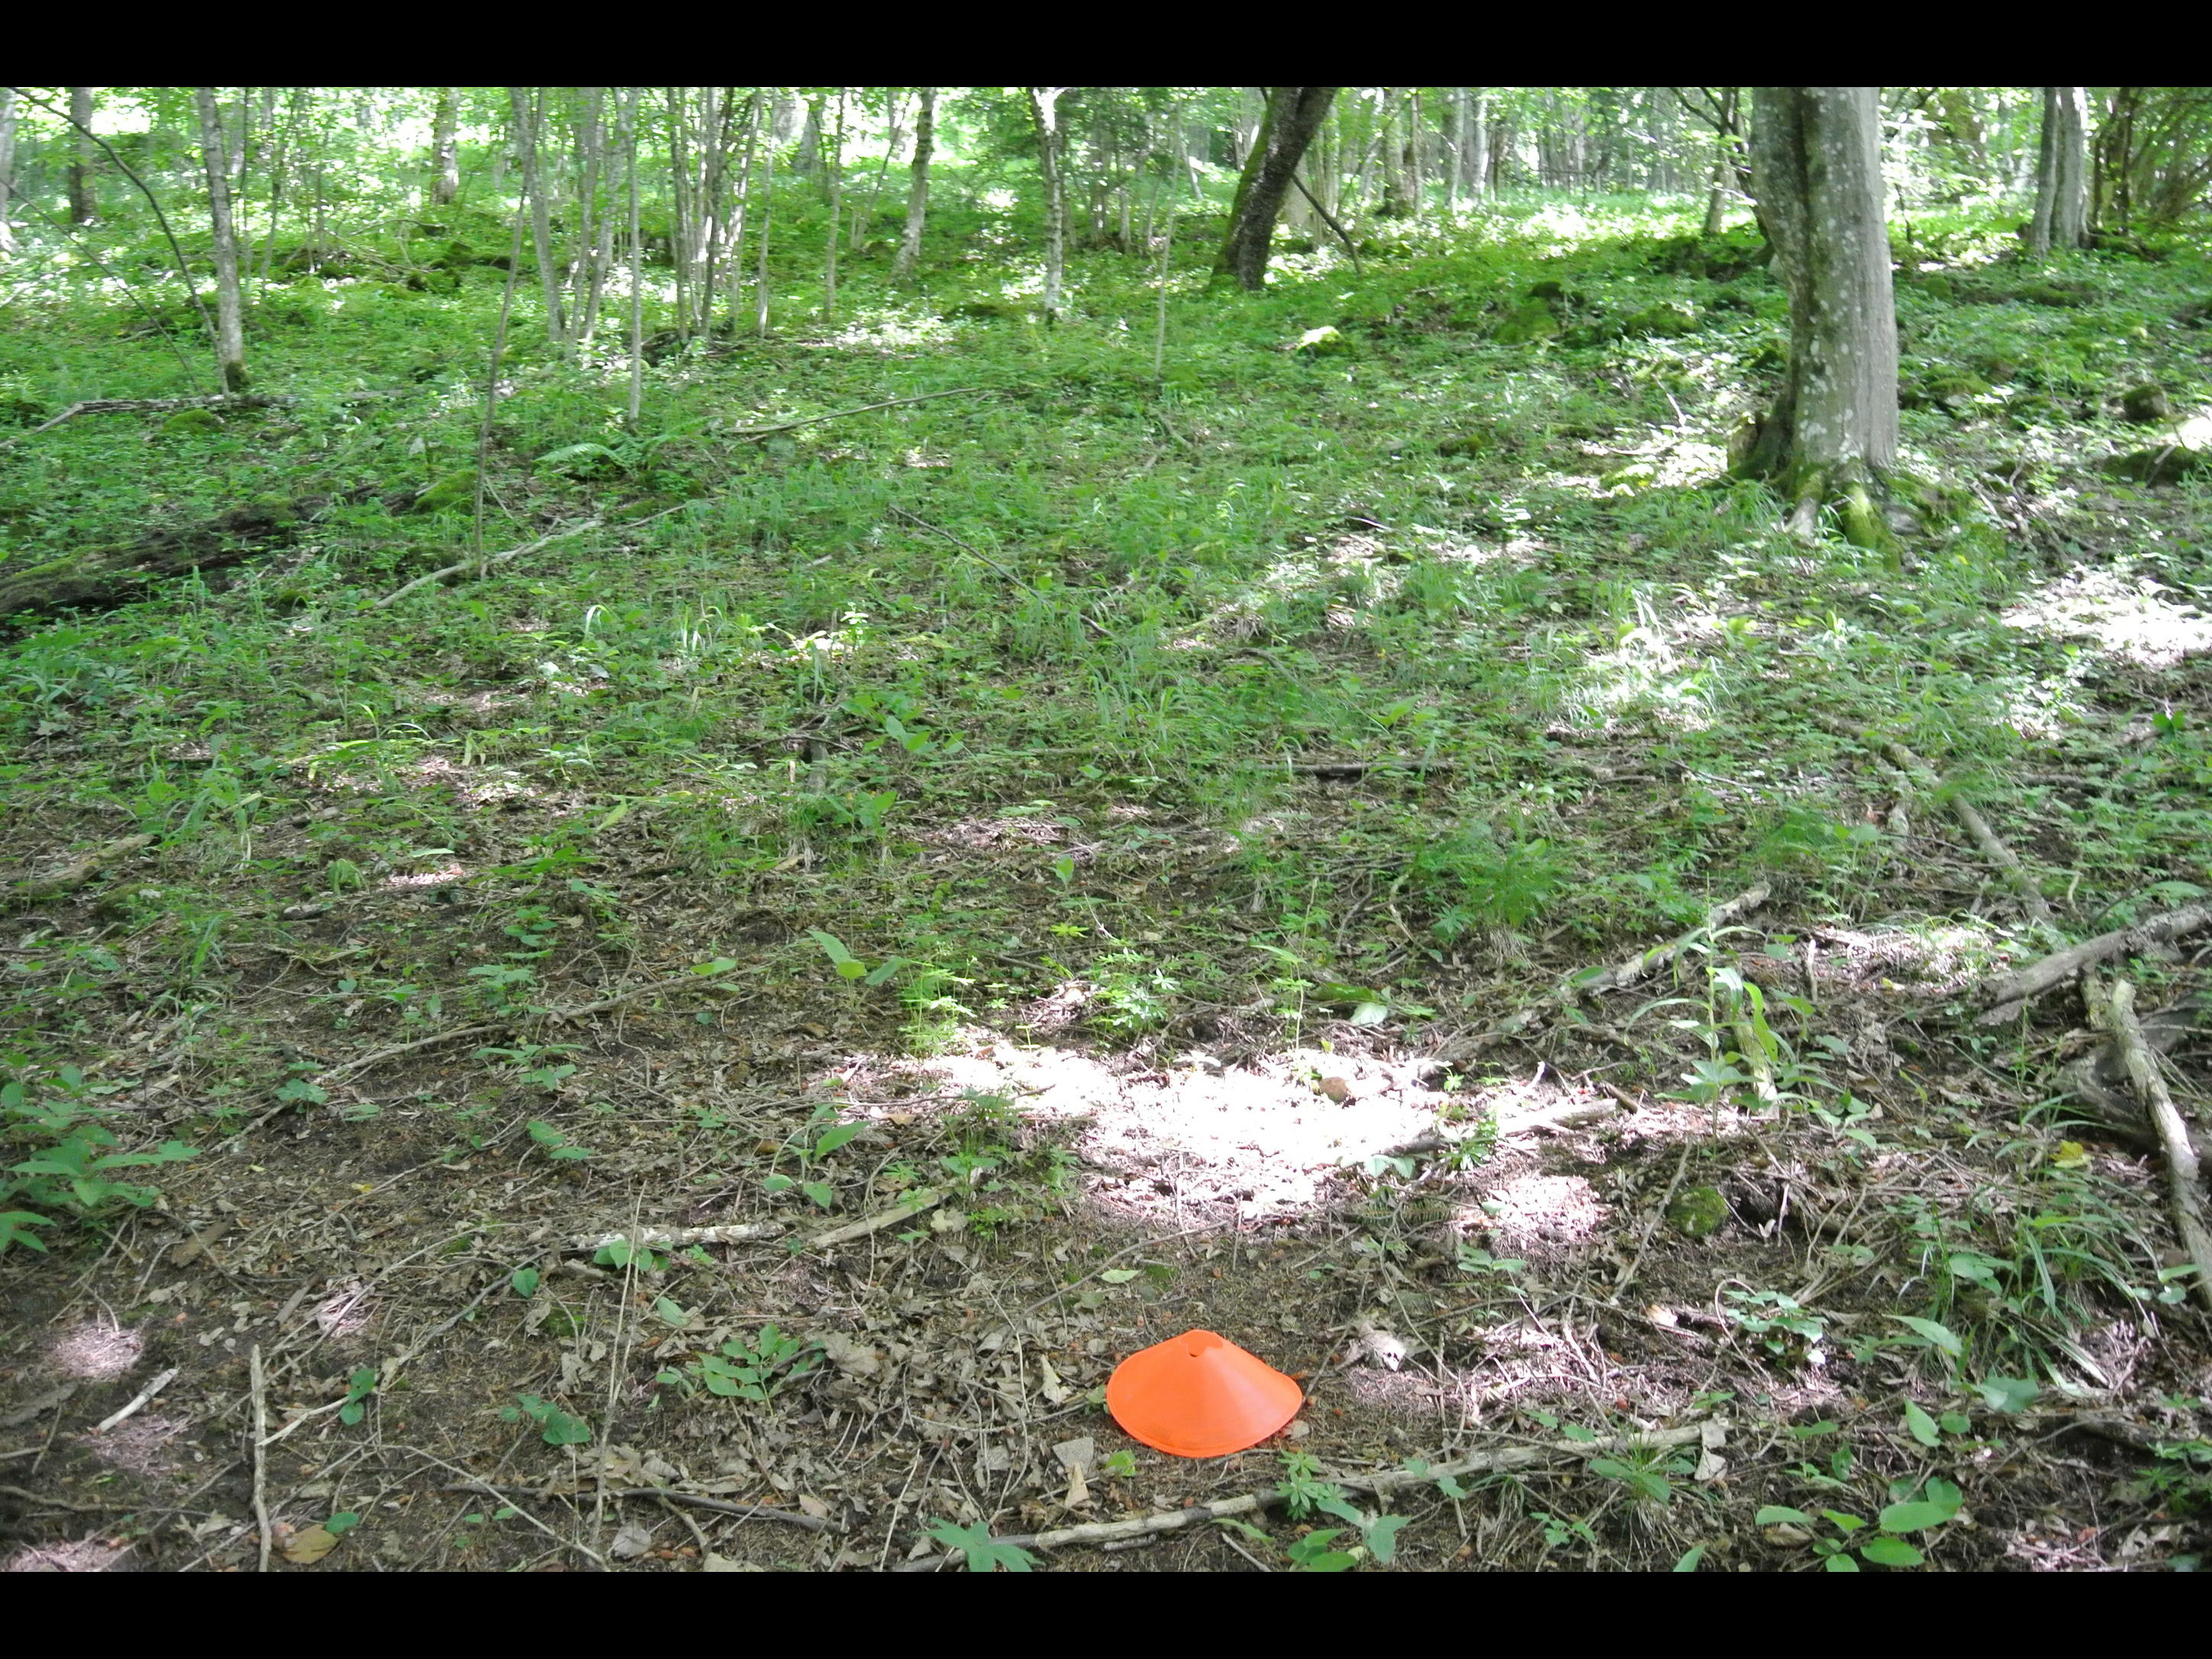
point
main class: Woodland
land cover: Spruce dominated mixed woodland
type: mountainous beech forest
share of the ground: > 75 %
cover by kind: broadleaved forest trees 65 %, coniferous forest trees 35 %
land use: Forestry
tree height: > 5 m
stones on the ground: < 10 %
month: June
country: AT
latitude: 47.9471
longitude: 15.3973
